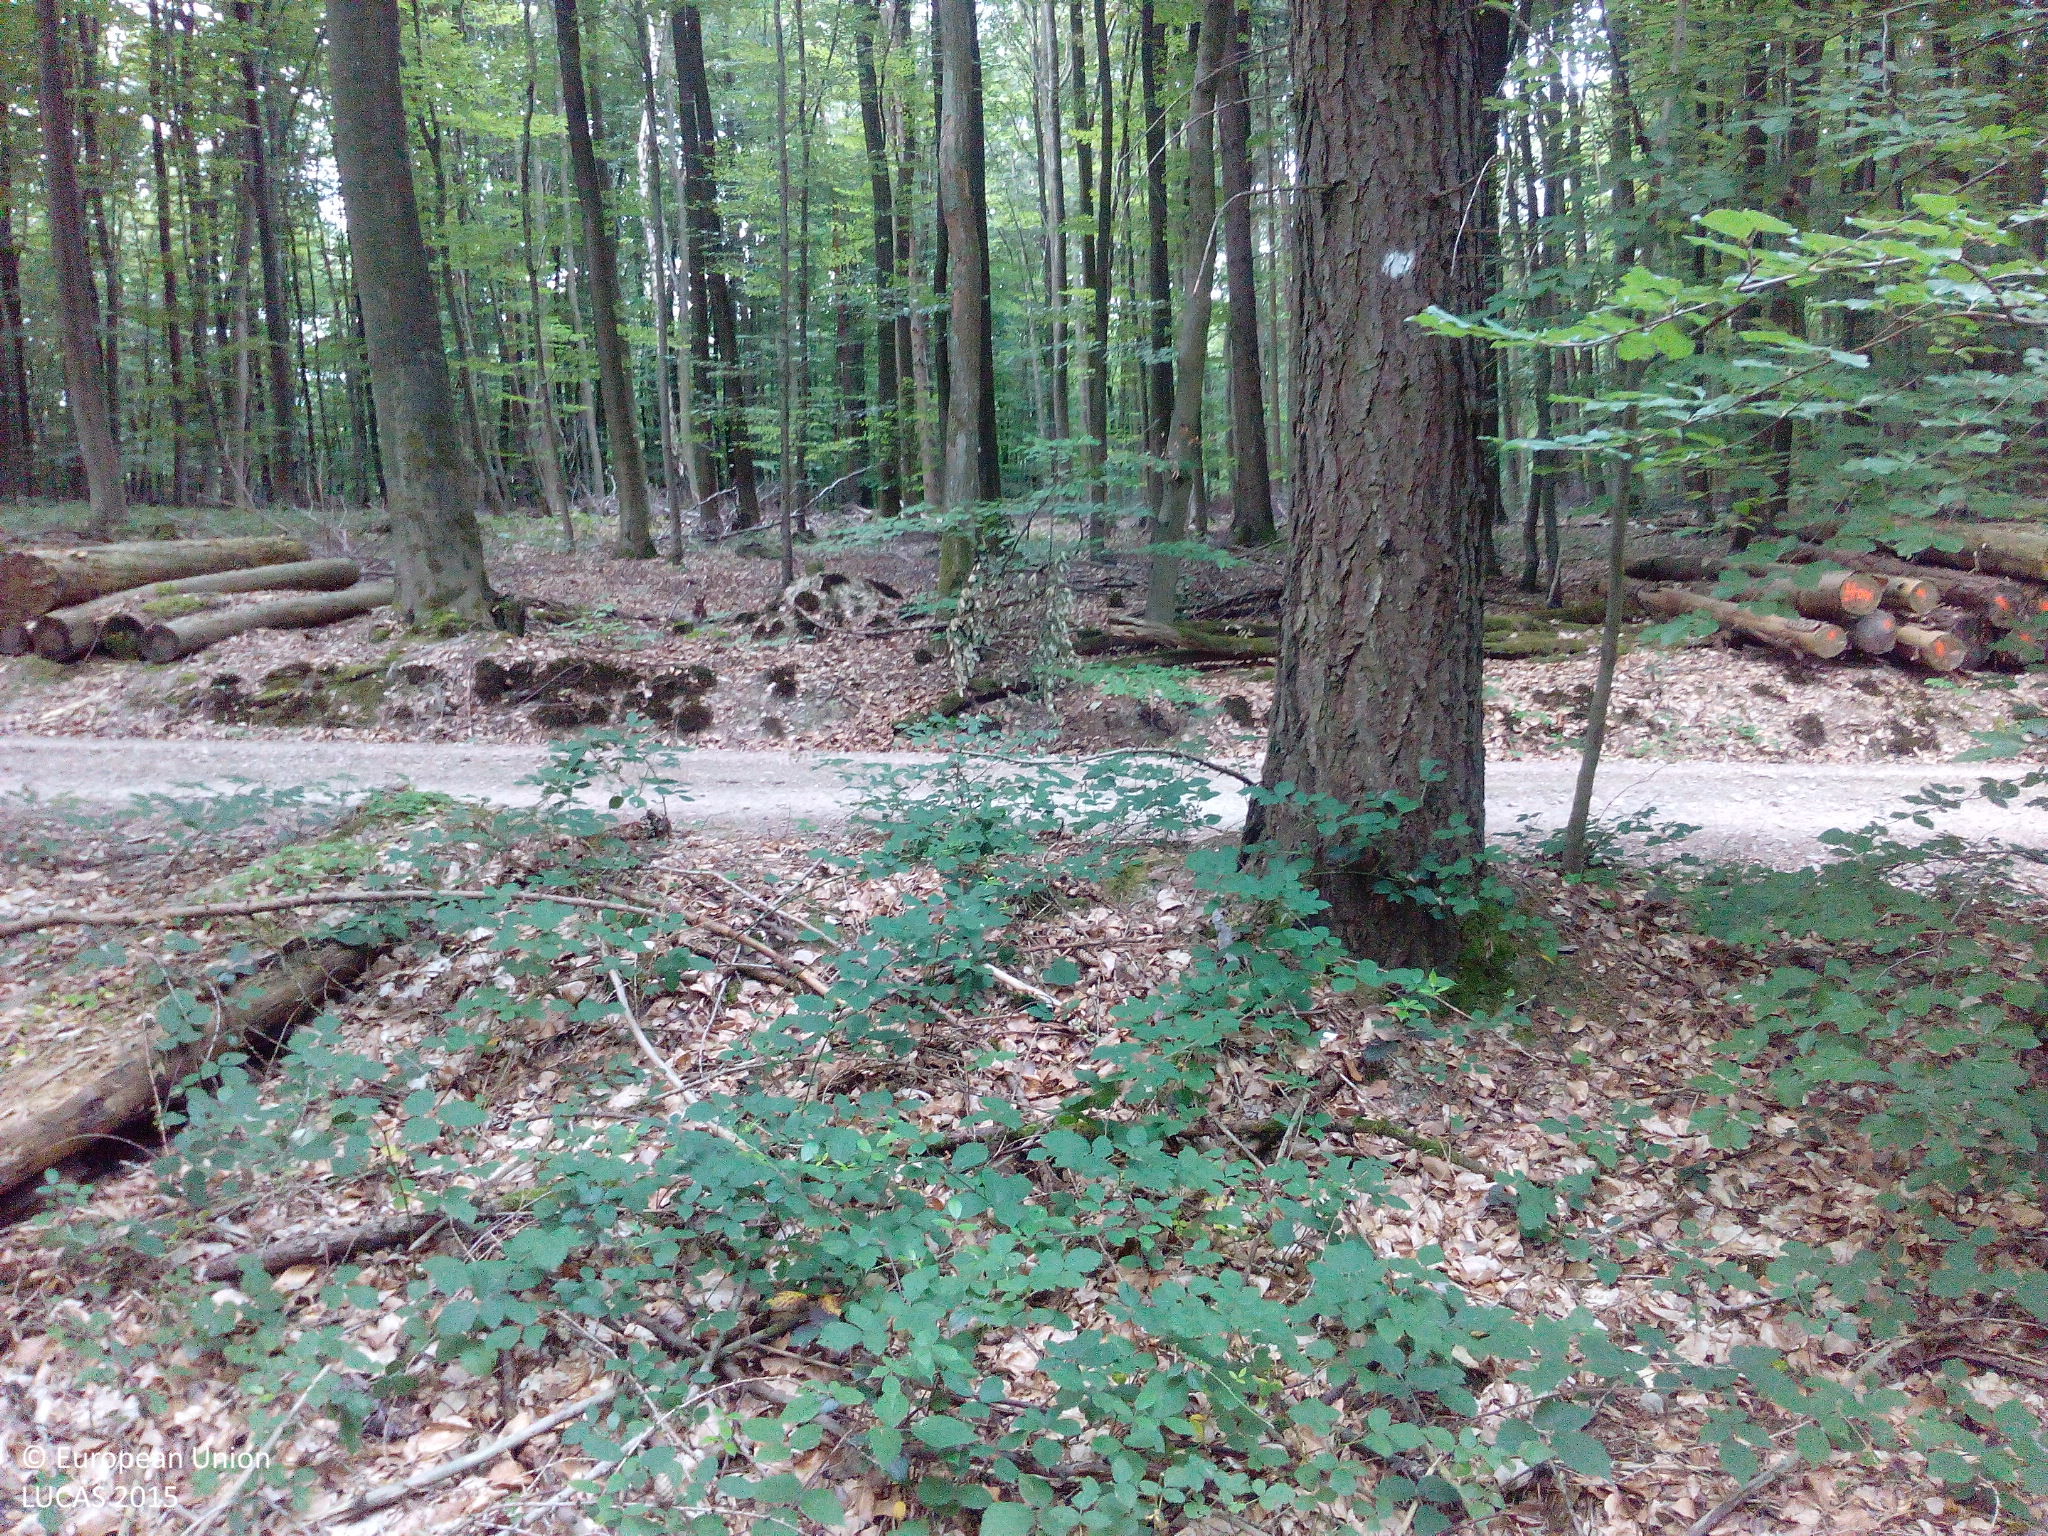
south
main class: Woodland
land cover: Other mixed woodland
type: hemiboreal forest and nemoral coniferous forest and mixed broadleaved-coniferous forest
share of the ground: 50 - 75 %
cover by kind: coniferous forest trees 45 %, unconsolidated bare surface 25 %, broadleaved forest trees 20 %, lichens and mosses 10 %
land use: Forestry
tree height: > 5 m
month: August
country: DE
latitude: 50.0792
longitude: 8.1418
